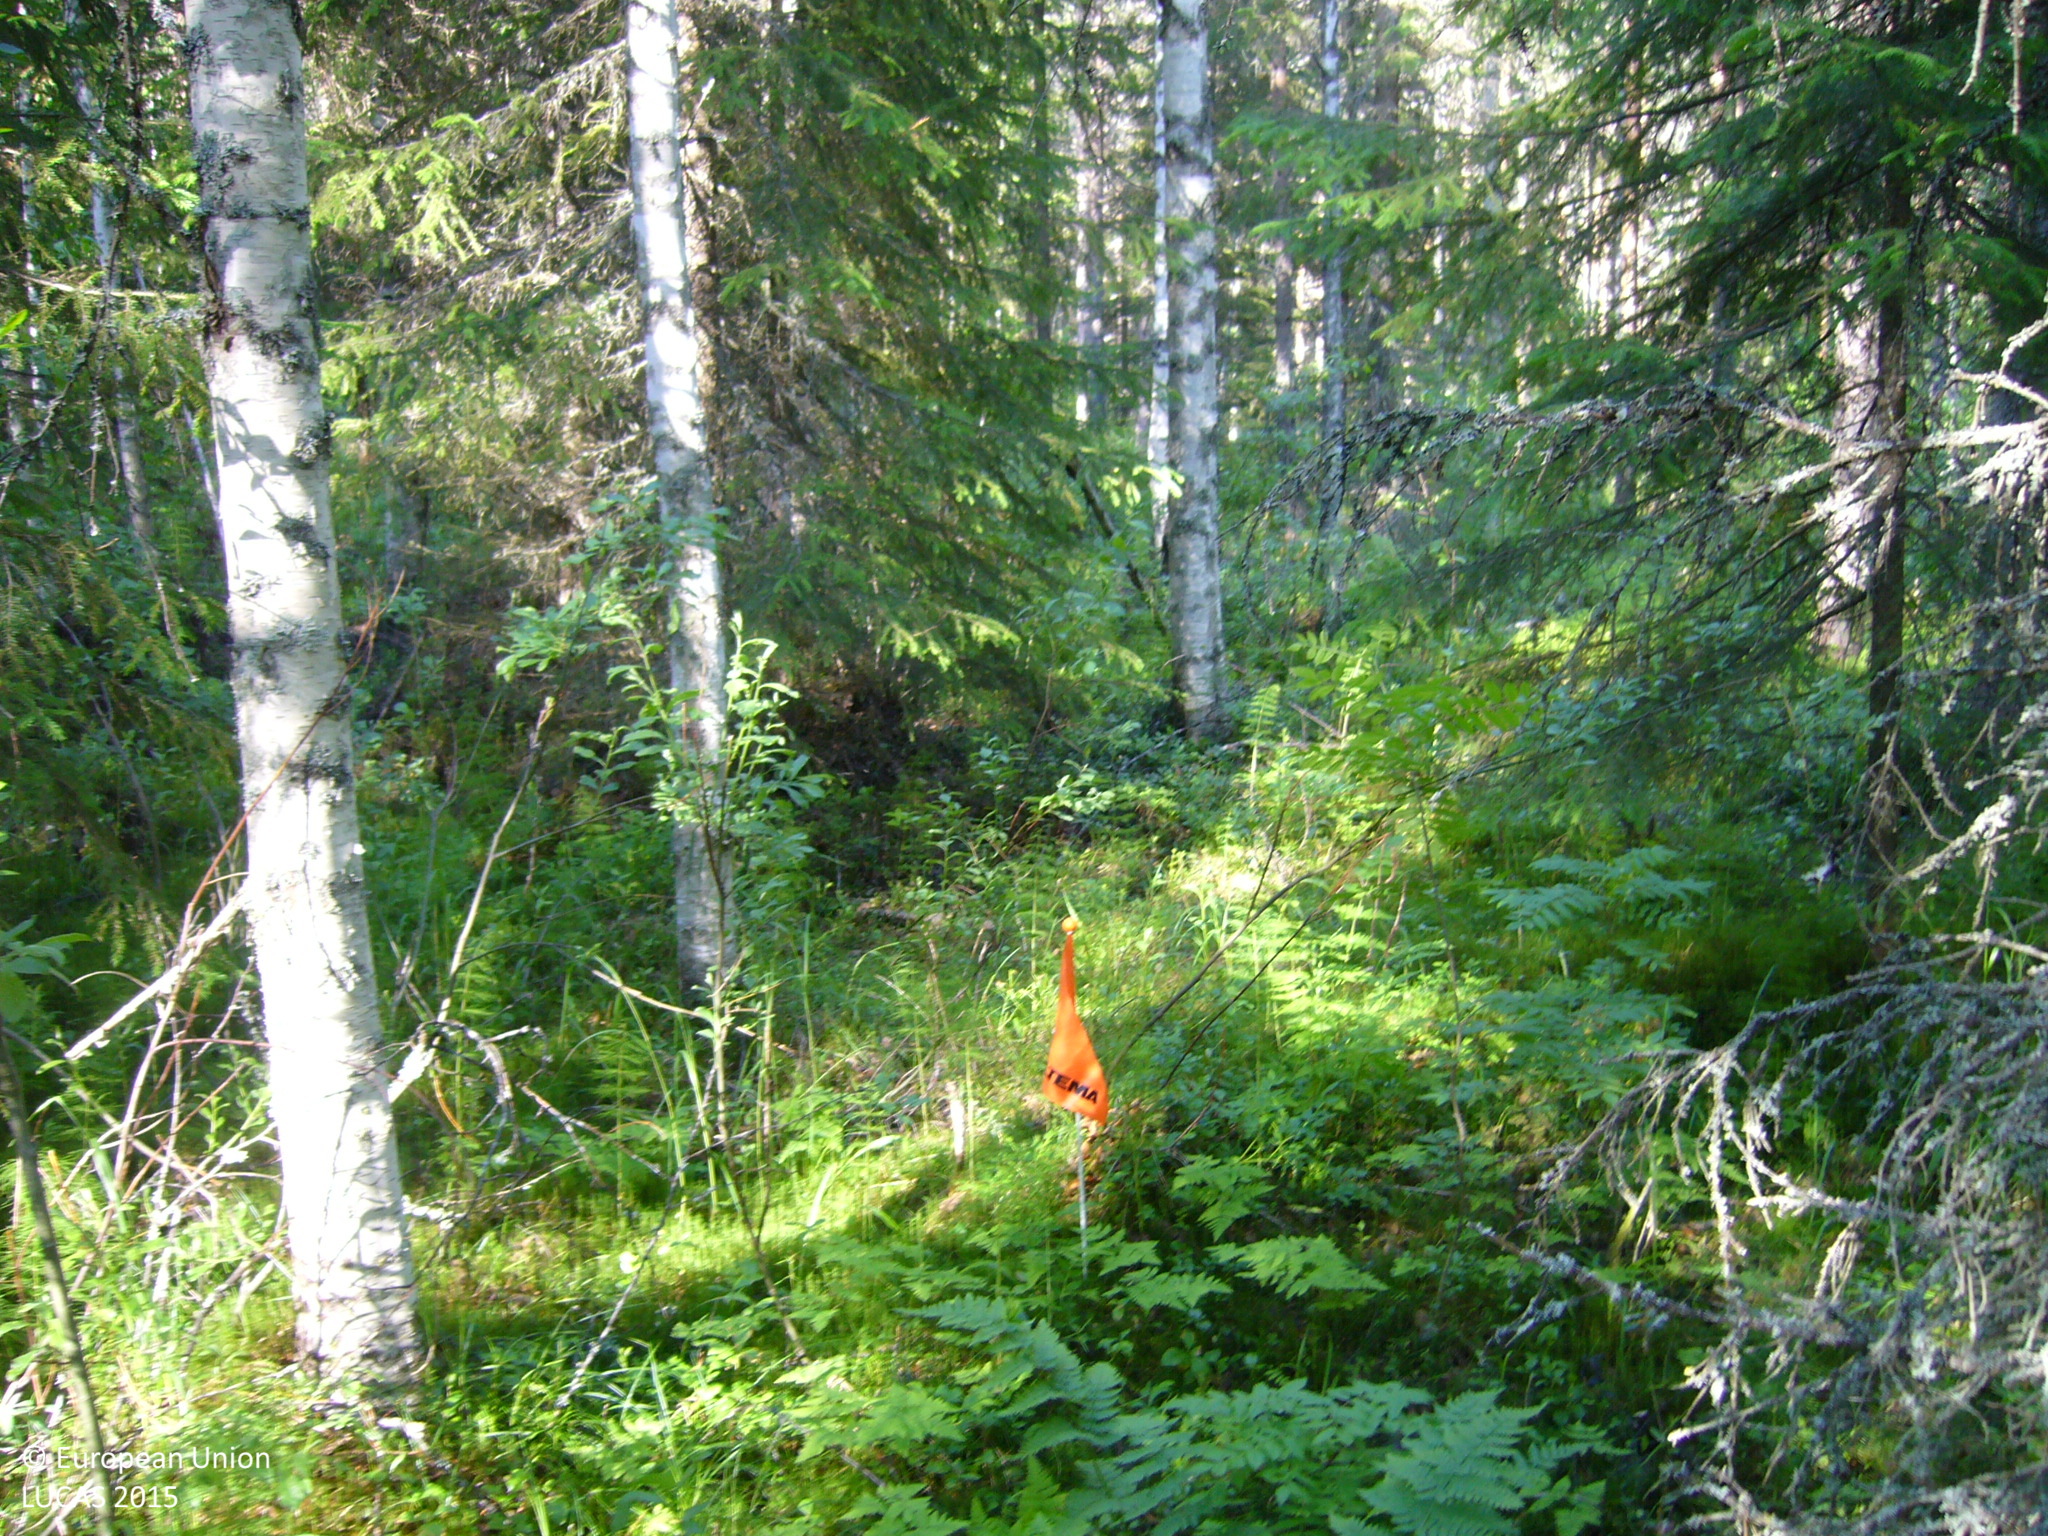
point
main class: Woodland
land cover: Spruce dominated mixed woodland
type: boreal forest
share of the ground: > 75 %
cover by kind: coniferous forest trees 50 %, broadleaved forest trees 40 %, shrubs 10 %
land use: Forestry
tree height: > 5 m
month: July
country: FI
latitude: 63.5015
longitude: 26.3751
